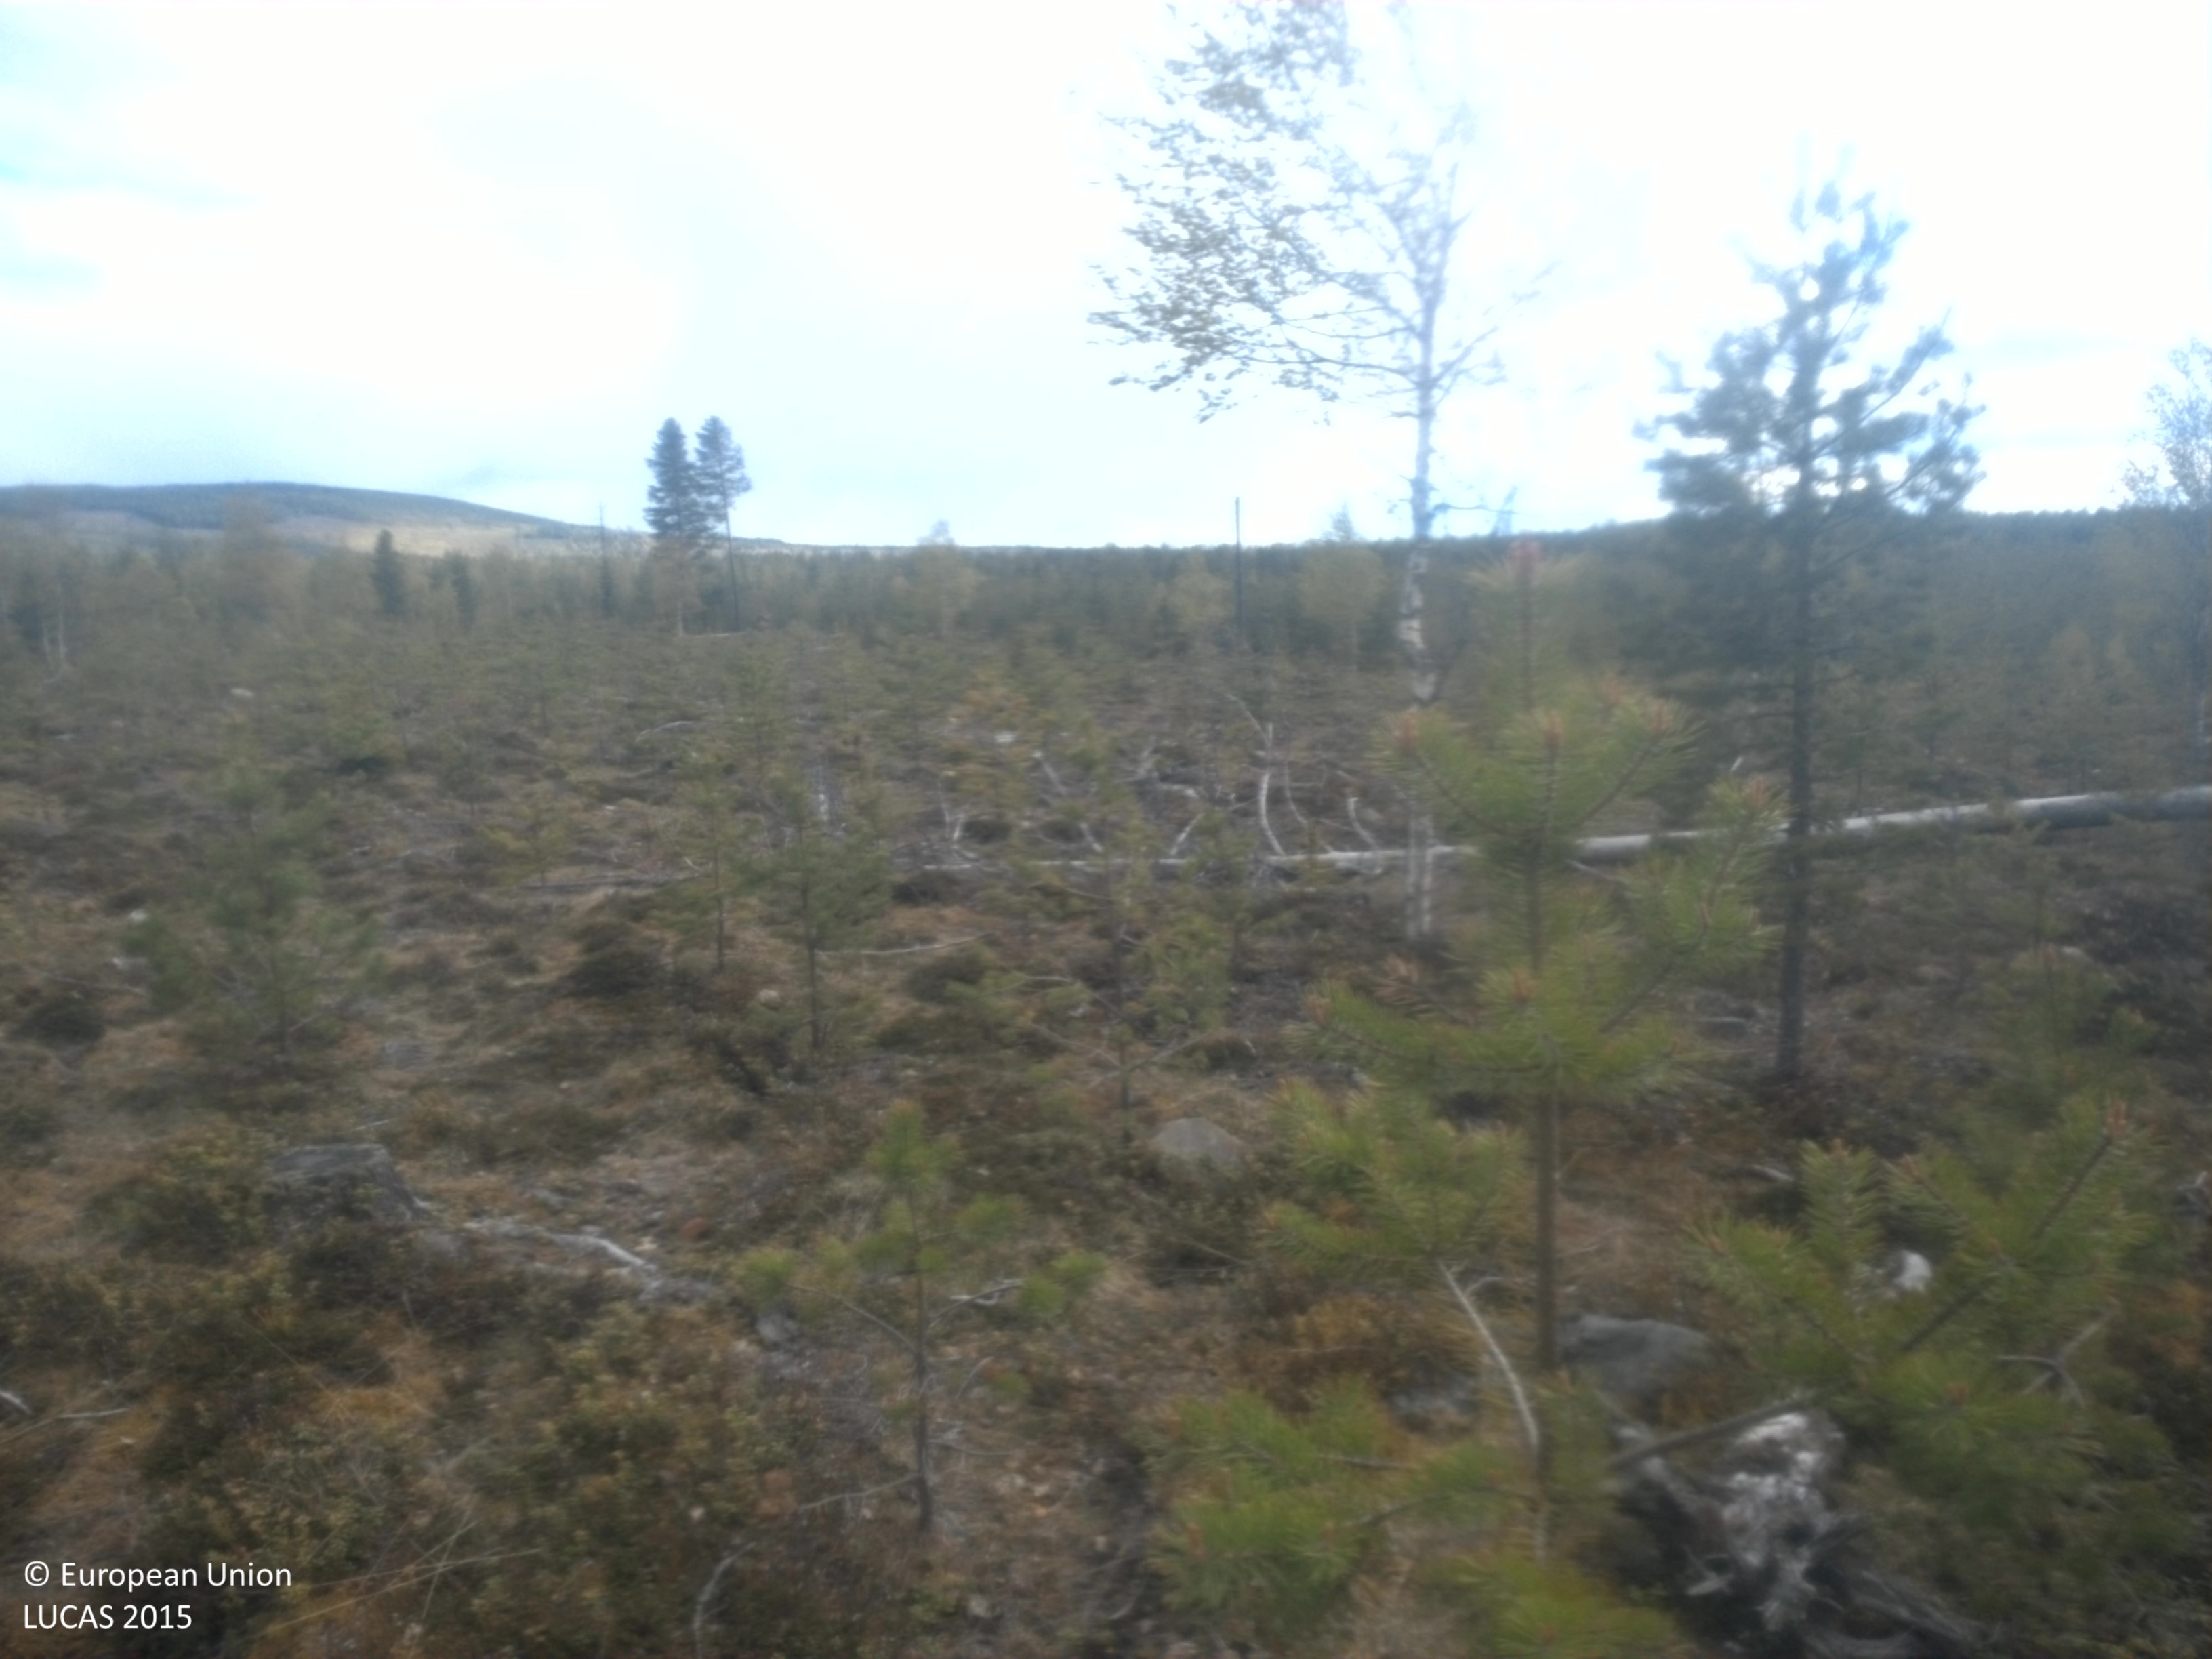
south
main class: Woodland
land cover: Pine dominated coniferous woodland
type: boreal forest
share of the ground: 10 - 25 %
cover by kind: herbaceous plants 35 %, lichens and mosses 25 %, coniferous forest trees 20 %, unconsolidated bare surface 10 %, broadleaved forest trees 5 %, shrubs 5 %
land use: Forestry
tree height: < 5 m
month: June
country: SE
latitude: 64.3746
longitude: 17.6981
